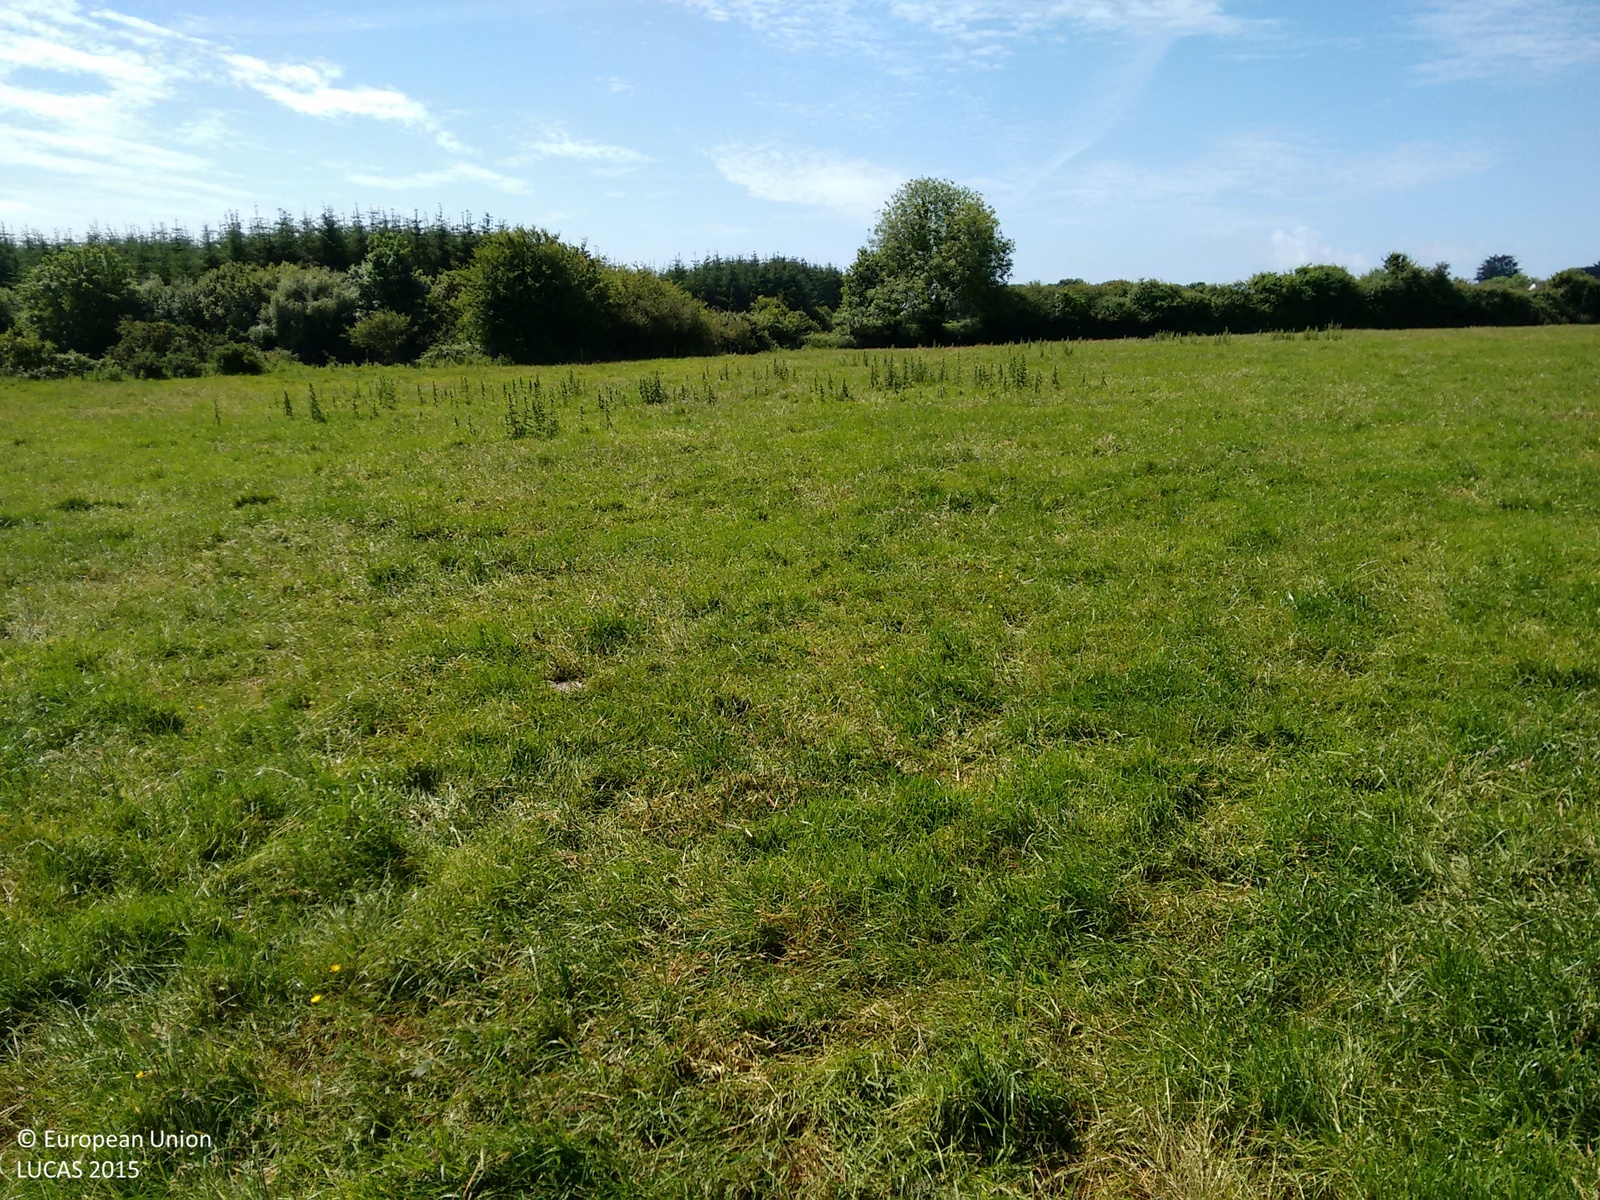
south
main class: Grassland
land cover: Grassland without tree/shrub cover
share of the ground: > 75 %
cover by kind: herbaceous plants 100 %
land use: Agriculture (excluding fallow land and kitchen gardens)
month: June
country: IE
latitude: 52.2162
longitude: -7.0498
